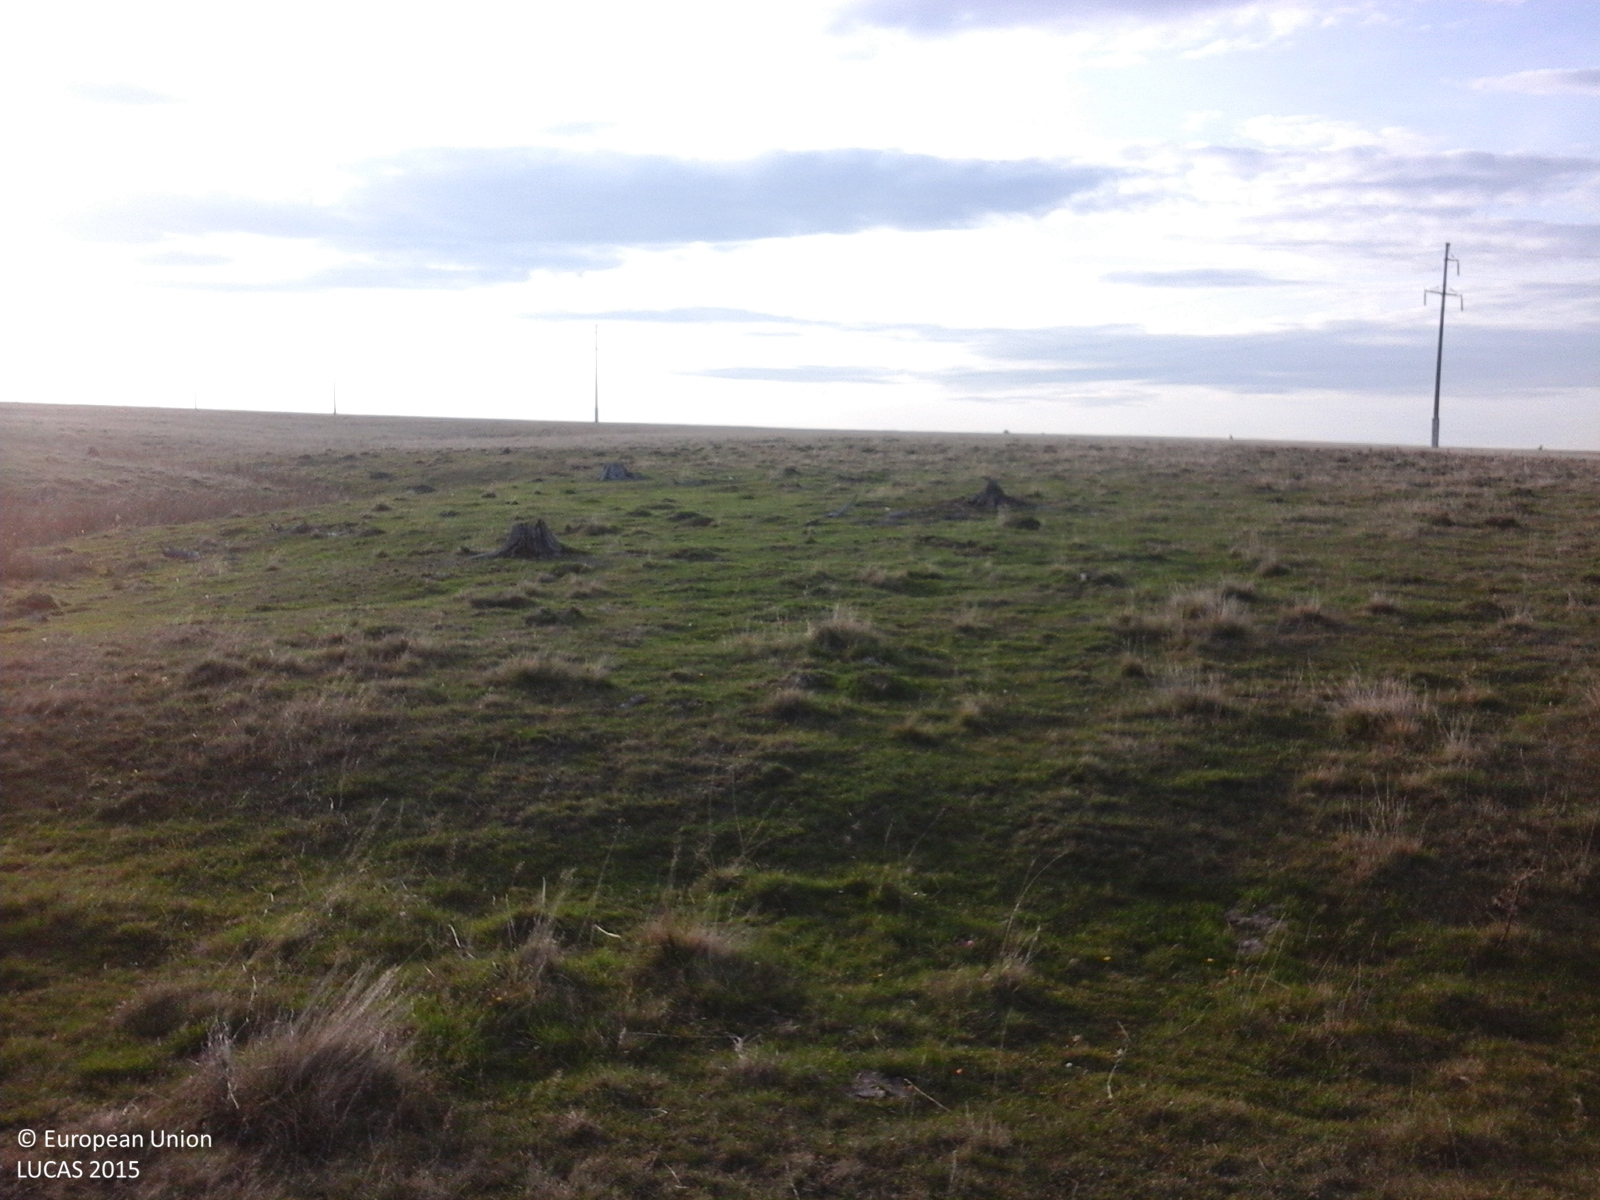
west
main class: Grassland
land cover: Grassland without tree/shrub cover
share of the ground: > 75 %
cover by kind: herbaceous plants 100 %
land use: Agriculture (excluding fallow land and kitchen gardens)
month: October
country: RO
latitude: 46.3380
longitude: 25.4497
